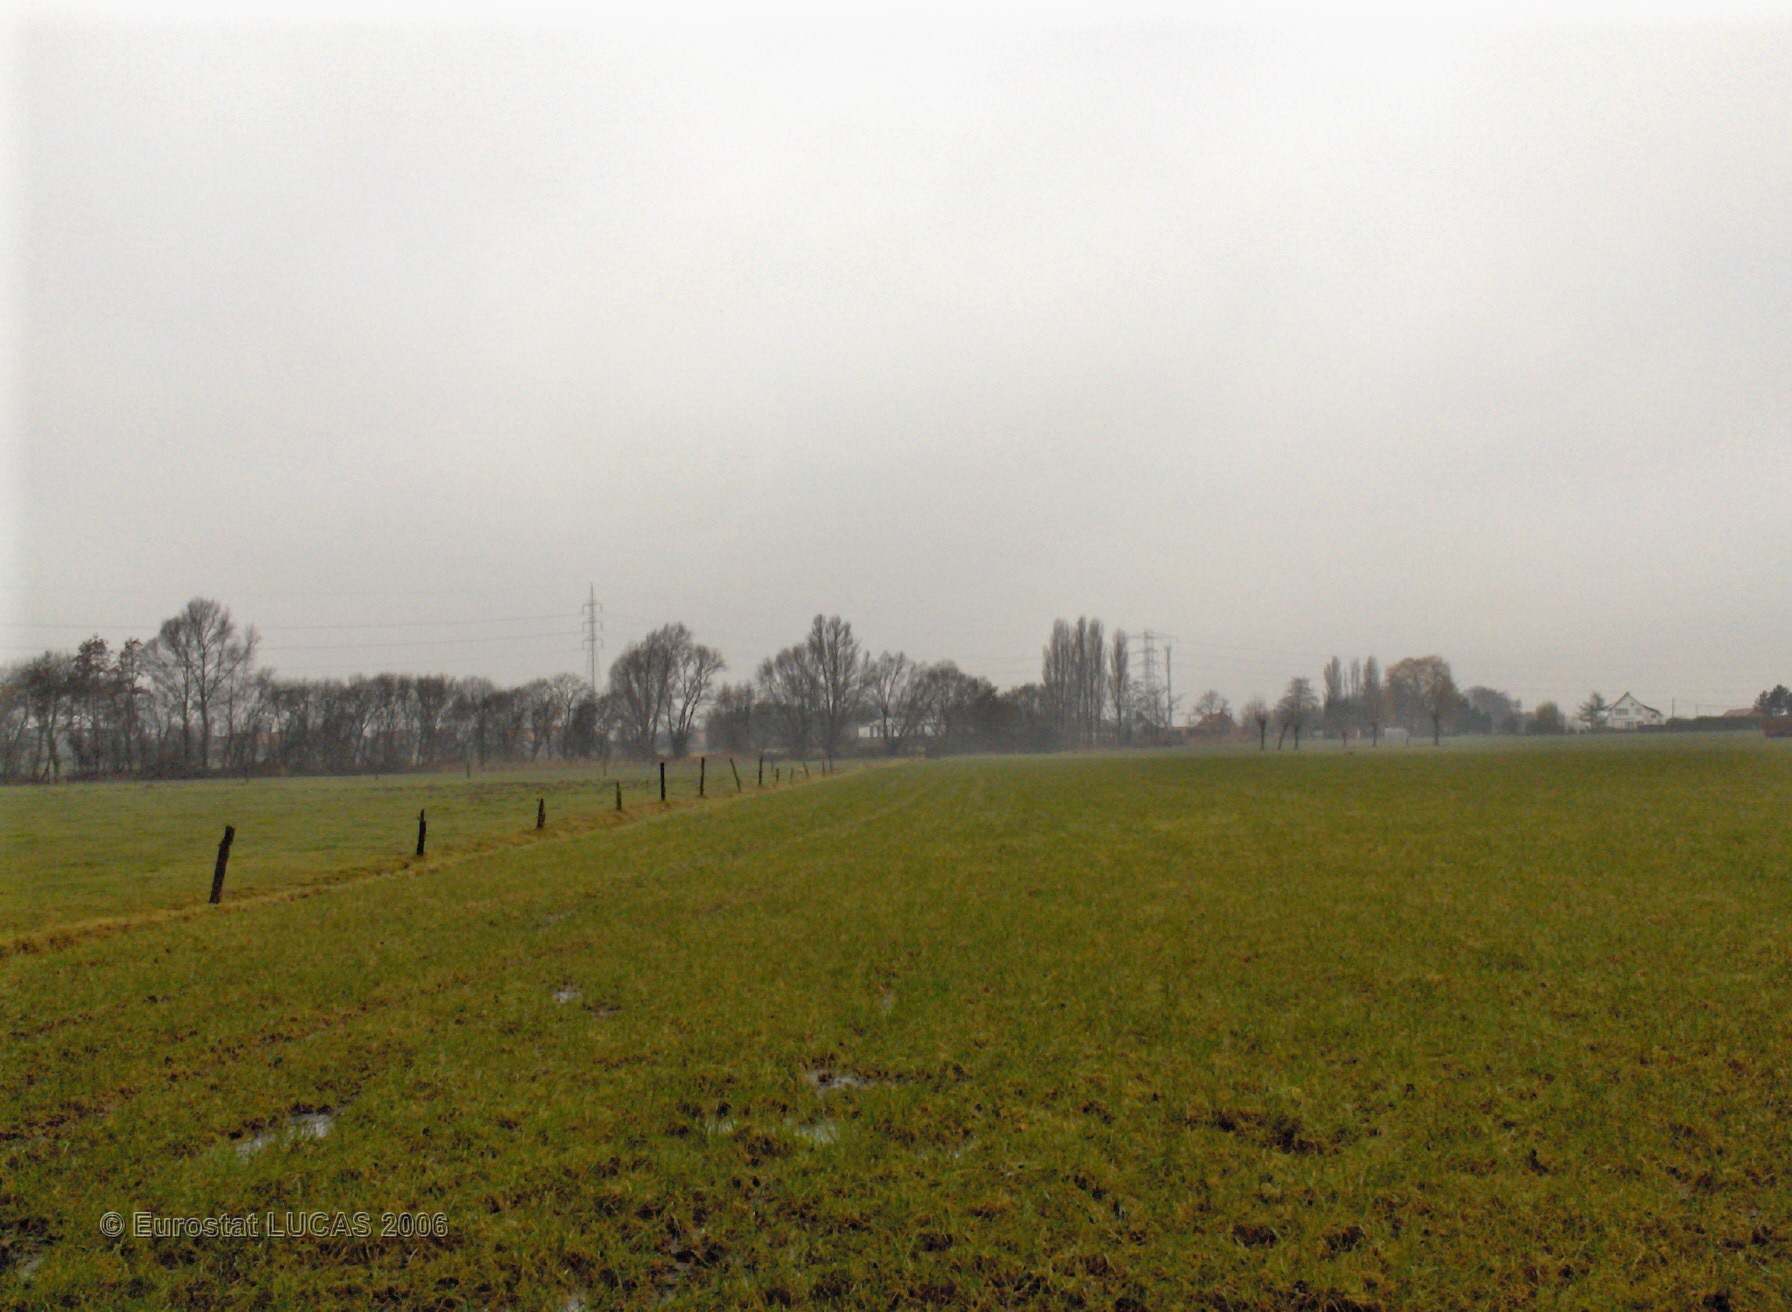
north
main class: Grassland
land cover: Grassland without tree/shrub cover
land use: Agriculture (excluding fallow land and kitchen gardens)
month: March
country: BE
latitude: 51.0954
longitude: 4.4697
